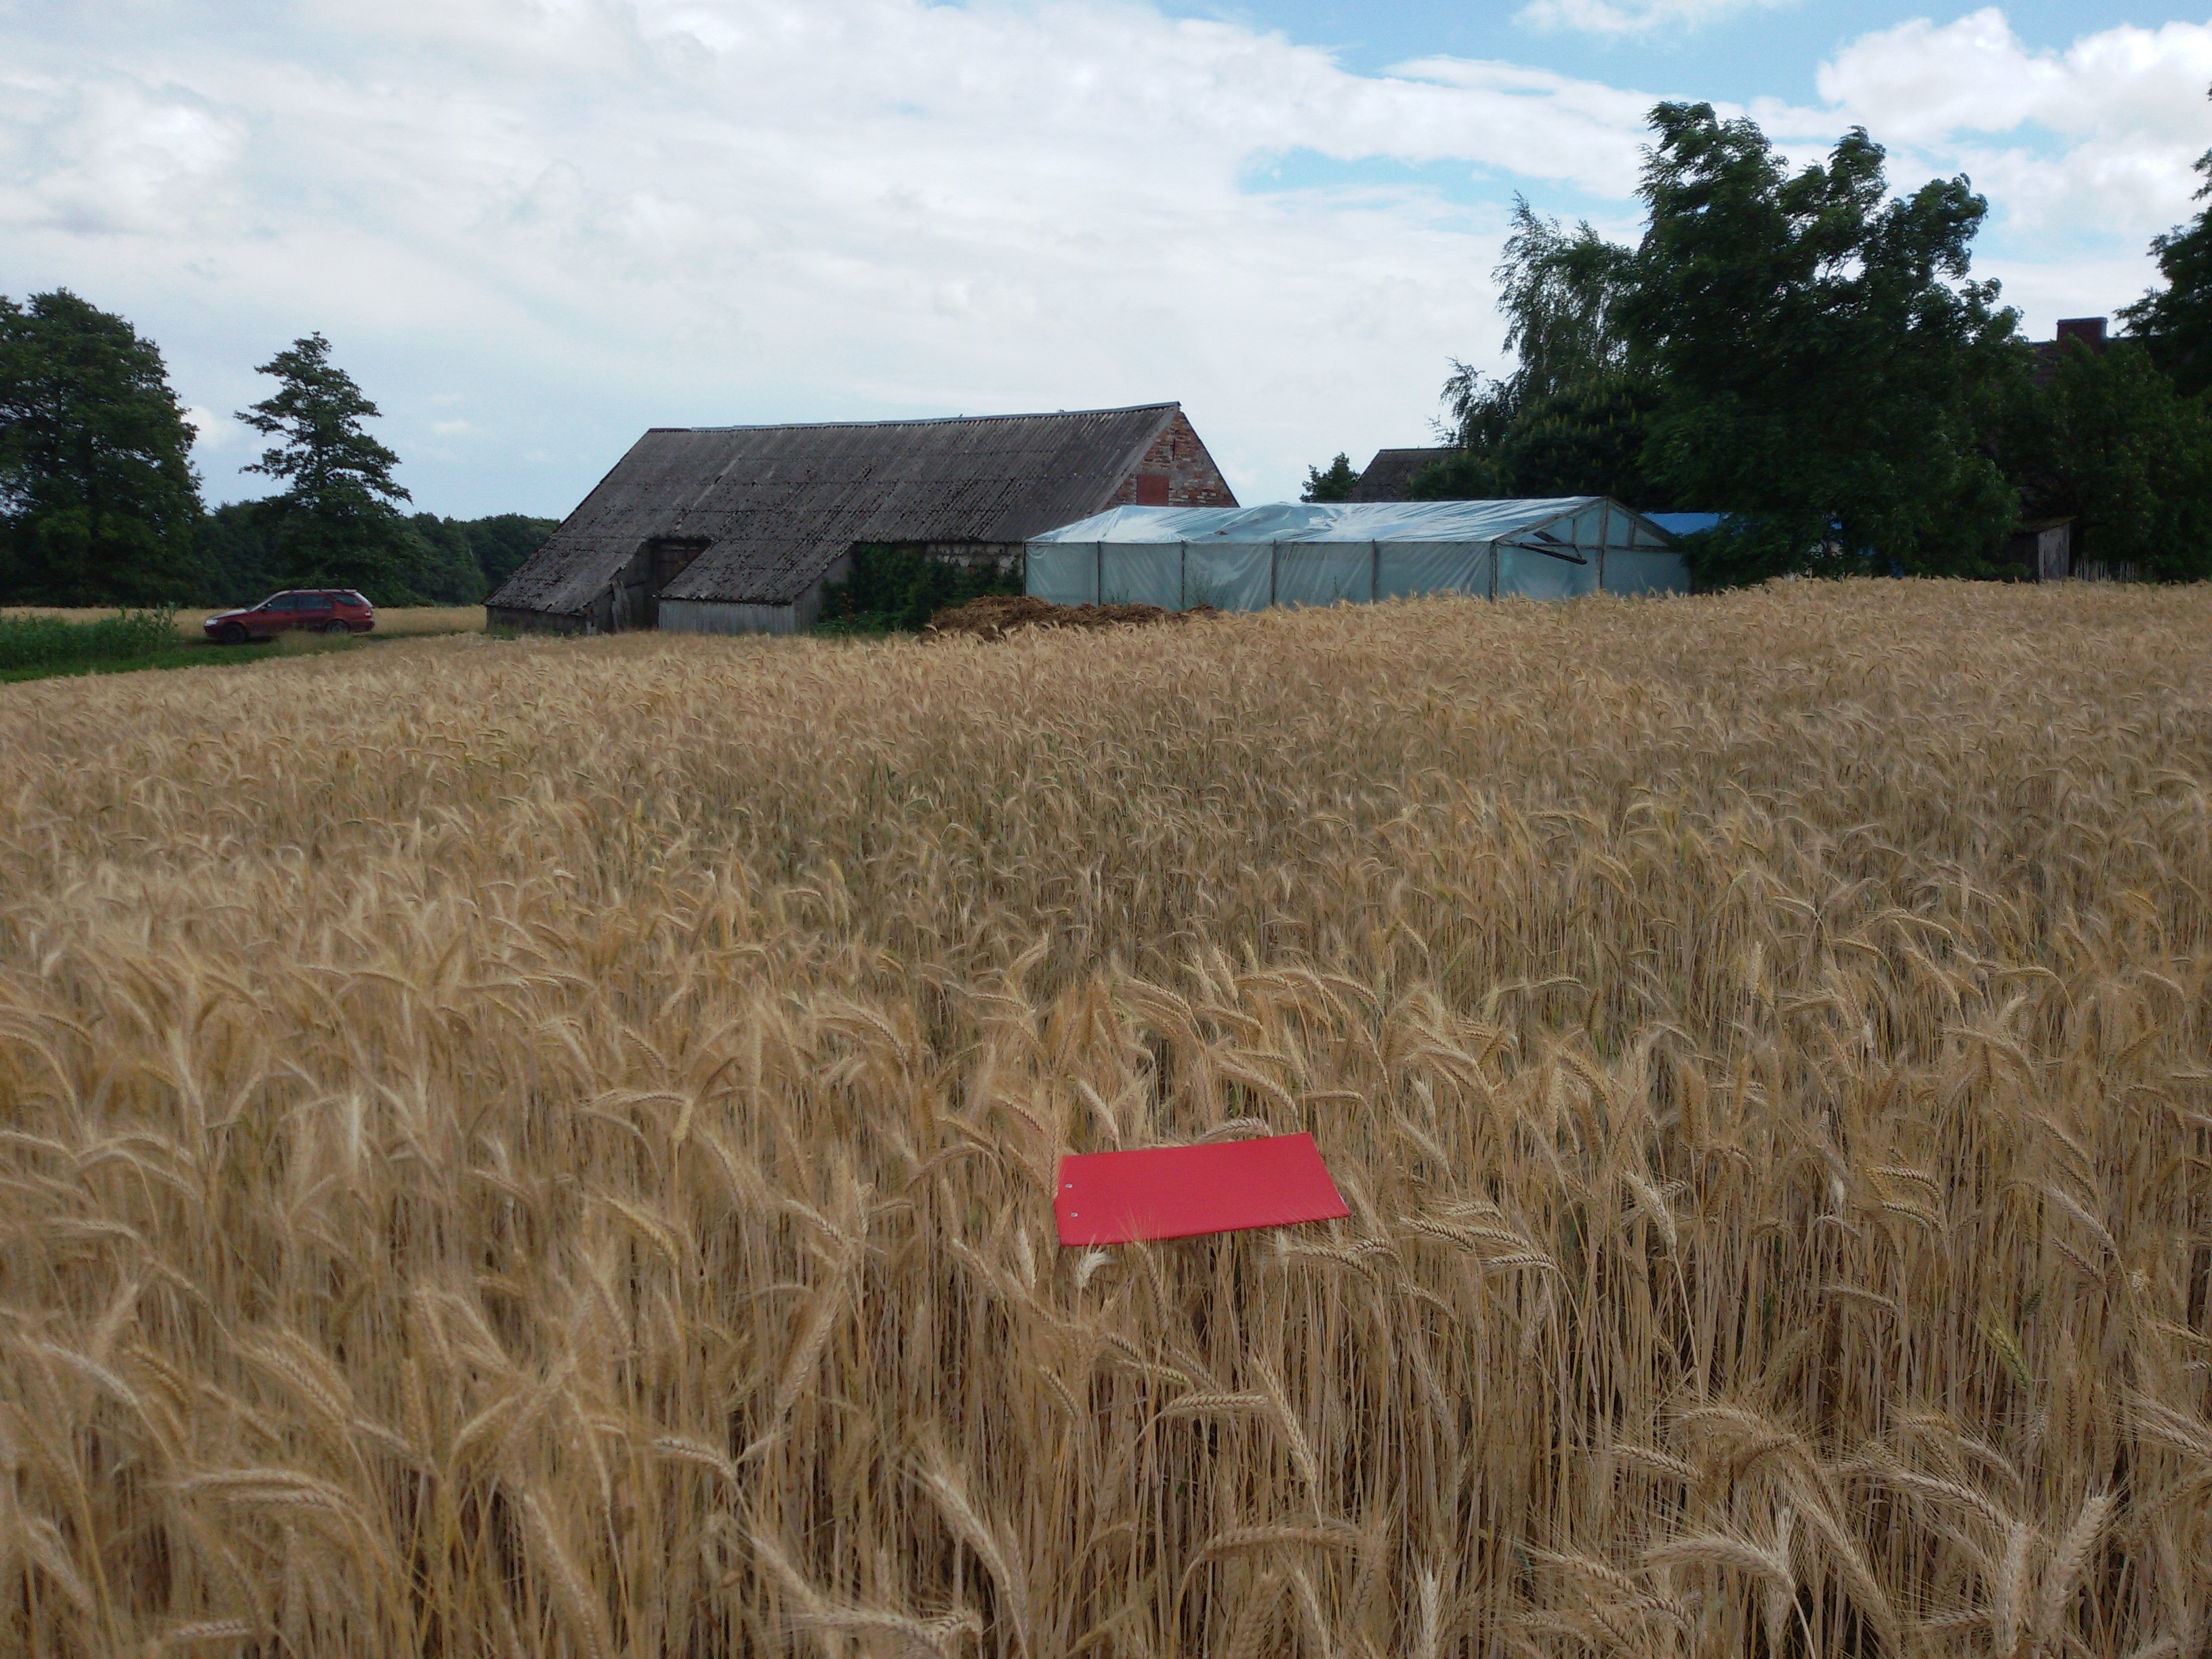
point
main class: Cropland
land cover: Triticale
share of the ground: > 75 %
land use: Agriculture (excluding fallow land and kitchen gardens)
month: July
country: PL
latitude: 52.8004
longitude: 17.6219
